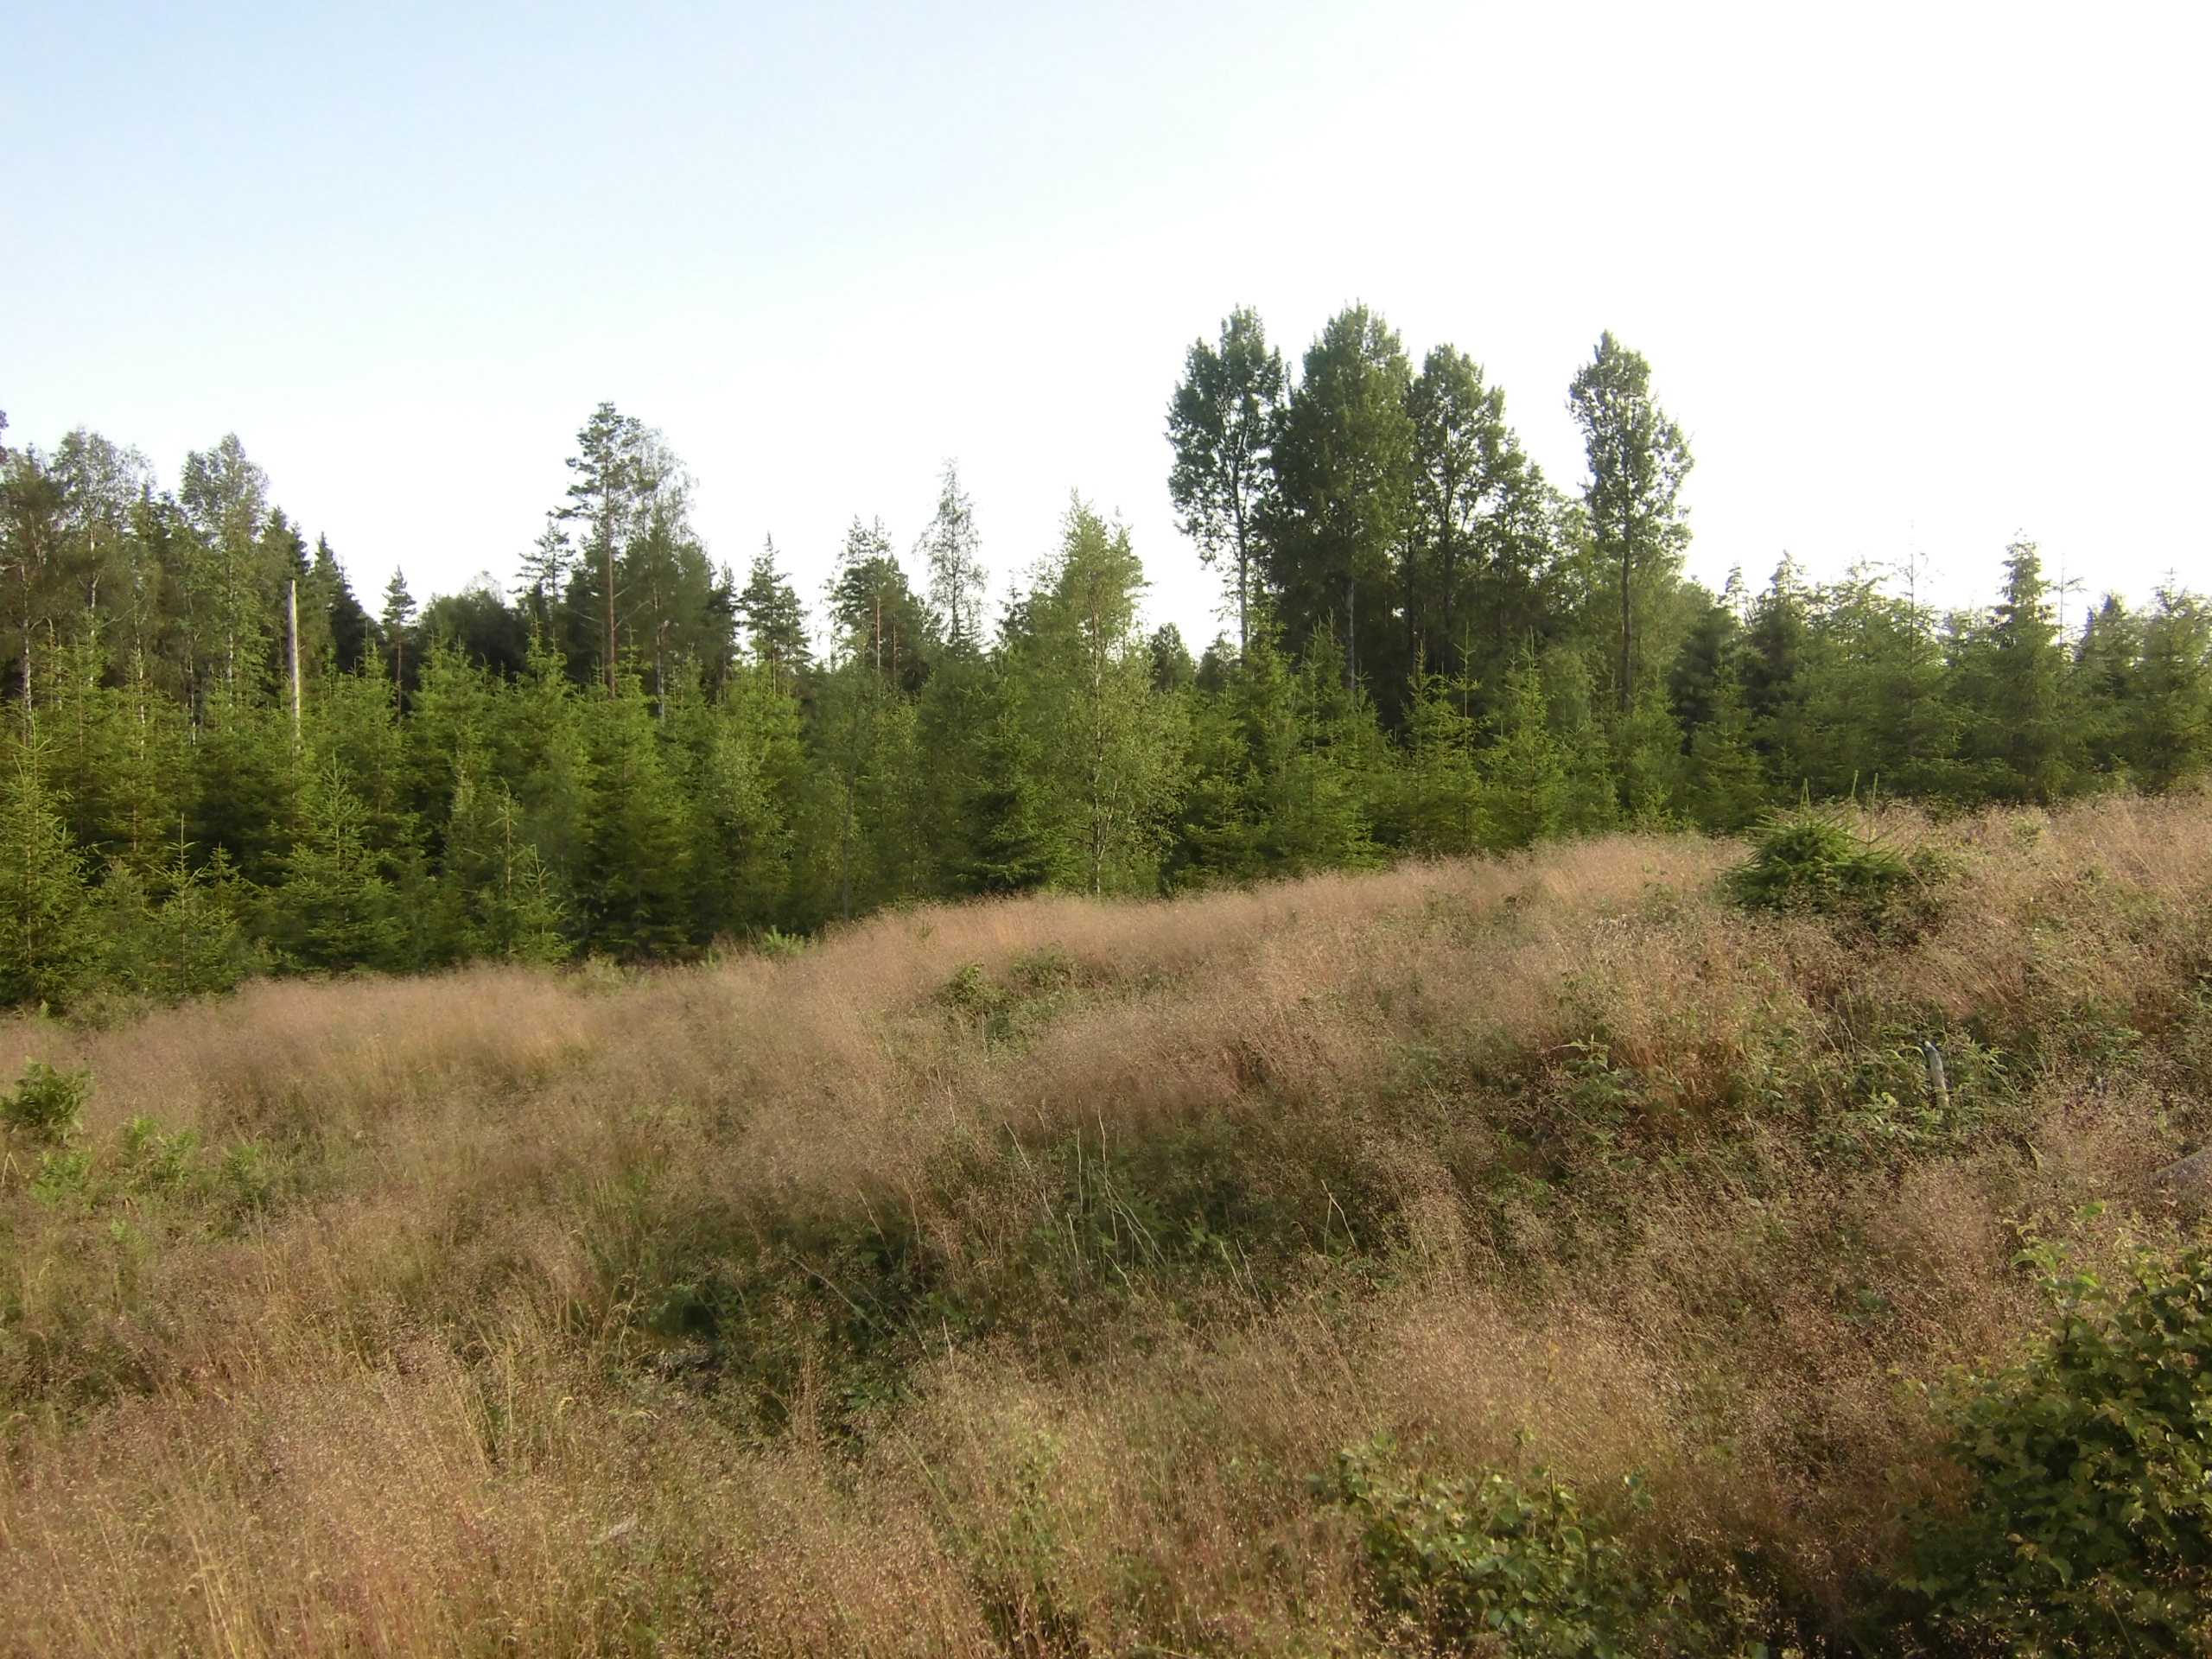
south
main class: Grassland
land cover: Grassland with sparse tree/shrub cover
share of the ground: > 75 %
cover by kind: herbaceous plants 70 %, lichens and mosses 10 %, unconsolidated bare surface 10 %, broadleaved forest trees 5 %, shrubs 5 %
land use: Forestry
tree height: < 5 m
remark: Clear cut
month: July
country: SE
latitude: 57.2159
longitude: 15.2462
